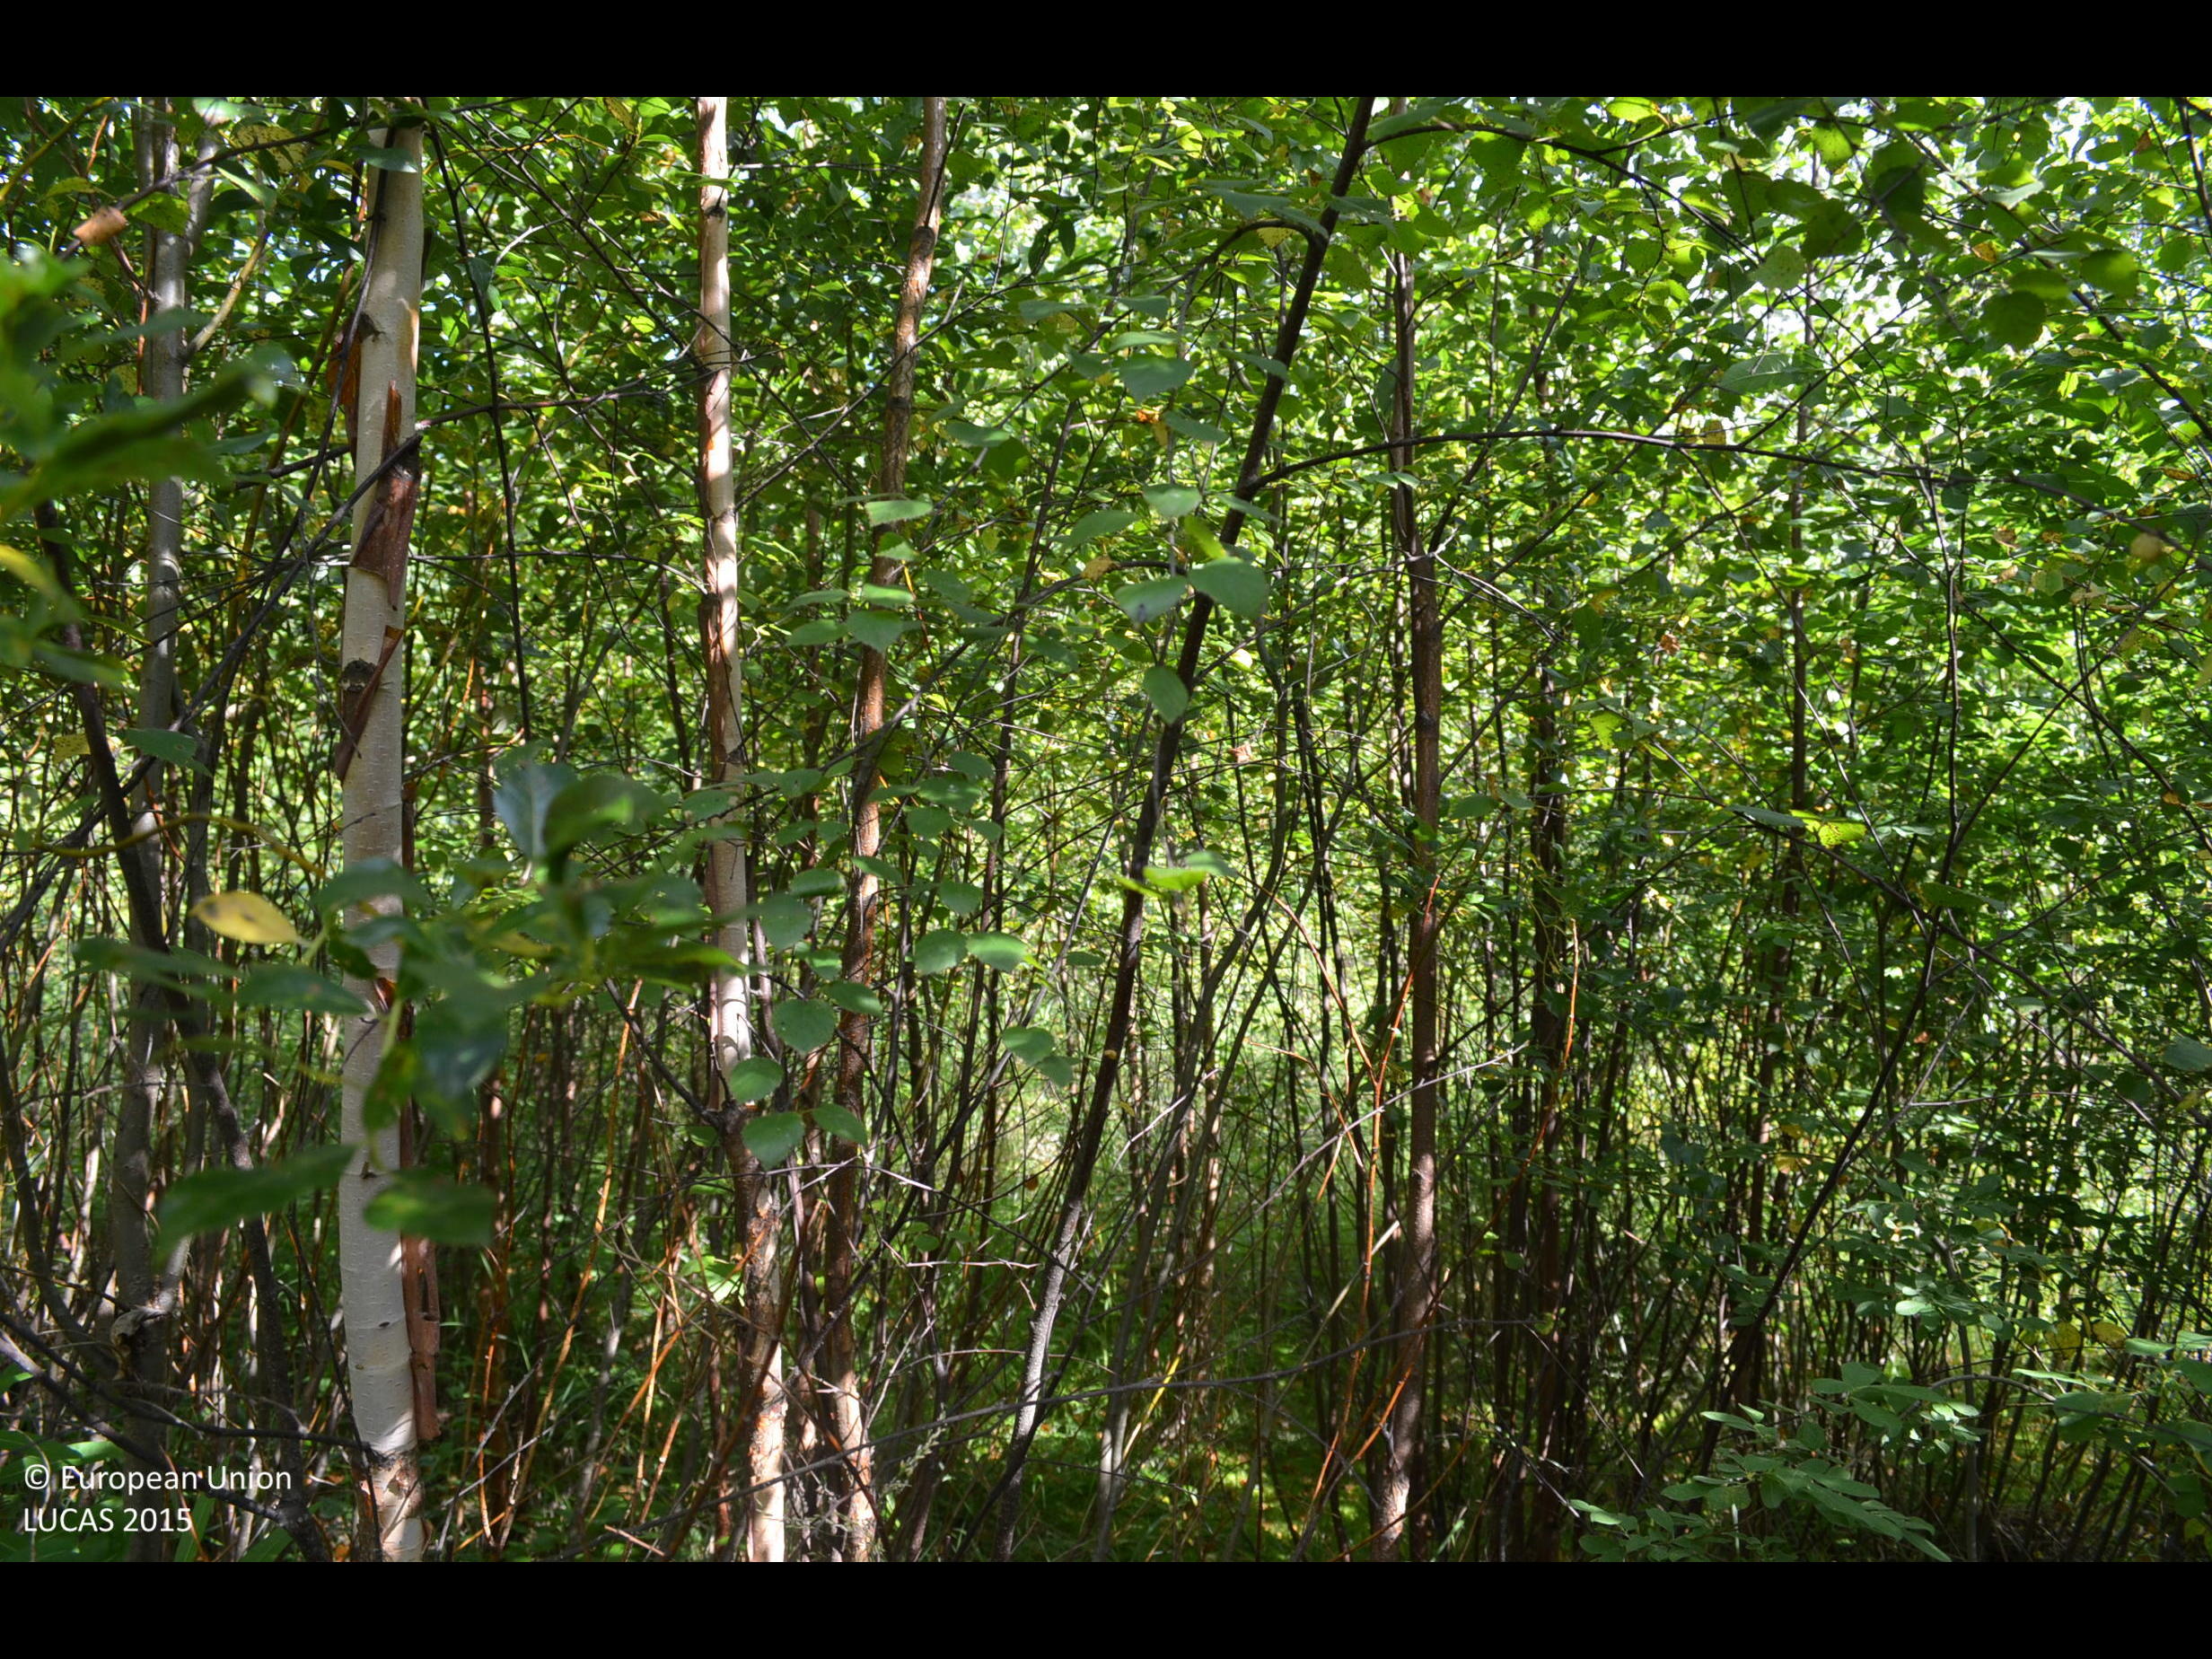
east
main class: Artificial land
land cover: Other artificial areas
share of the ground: > 75 %
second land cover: Broadleaved woodland
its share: > 75 %
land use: Electricity, gas and thermal power distribution
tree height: < 5 m
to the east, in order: Artificial constructions in urban areas; Broadleaved woodland; Electric lines; Broadleaved woodland; Electric lines; Shrubland without tree cover; Pine dominated mixed woodland; Other coniferous woodland; Spruce dominated coniferous woodland; Spruce dominated mixed woodland
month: August
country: FI
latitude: 62.0643
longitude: 24.1893
